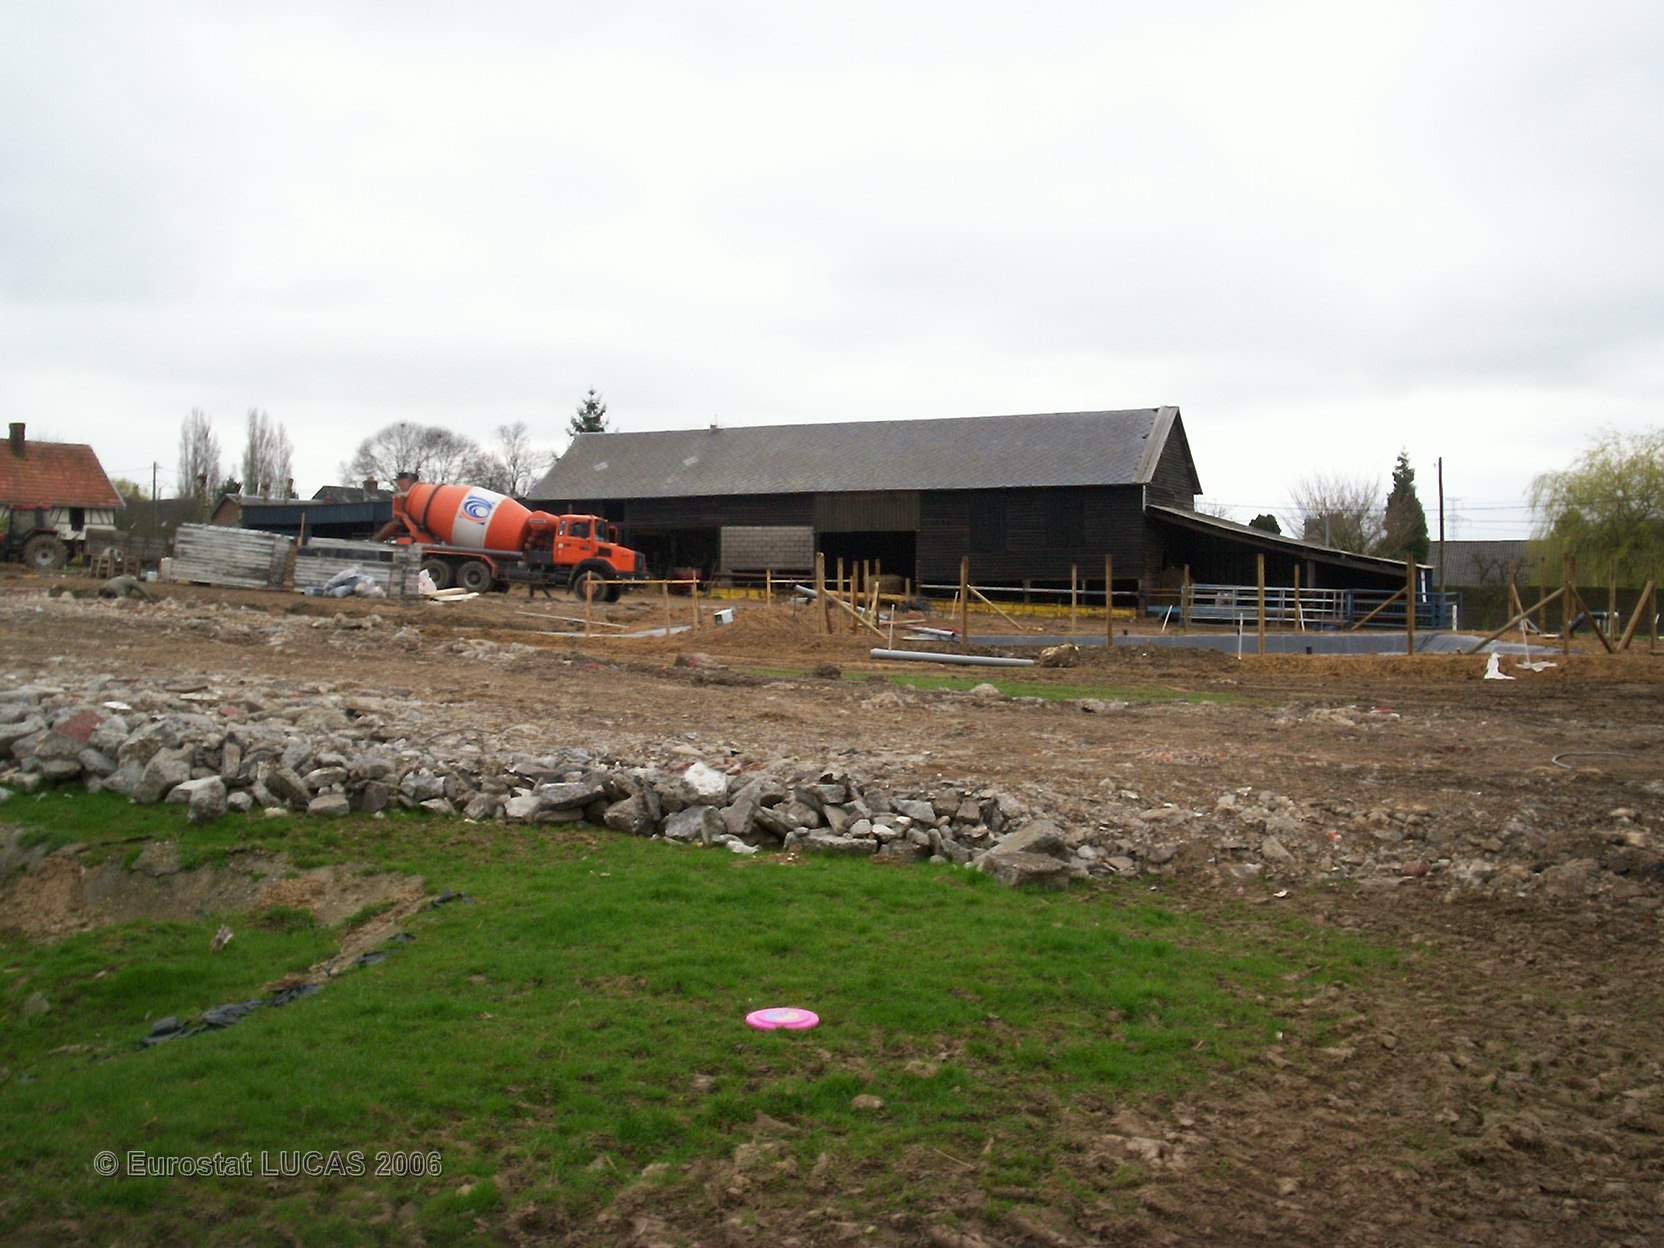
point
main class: Grassland
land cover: Grassland without tree/shrub cover
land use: Agriculture (excluding fallow land and kitchen gardens)
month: April
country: FR
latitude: 49.4988
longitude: 0.9610
